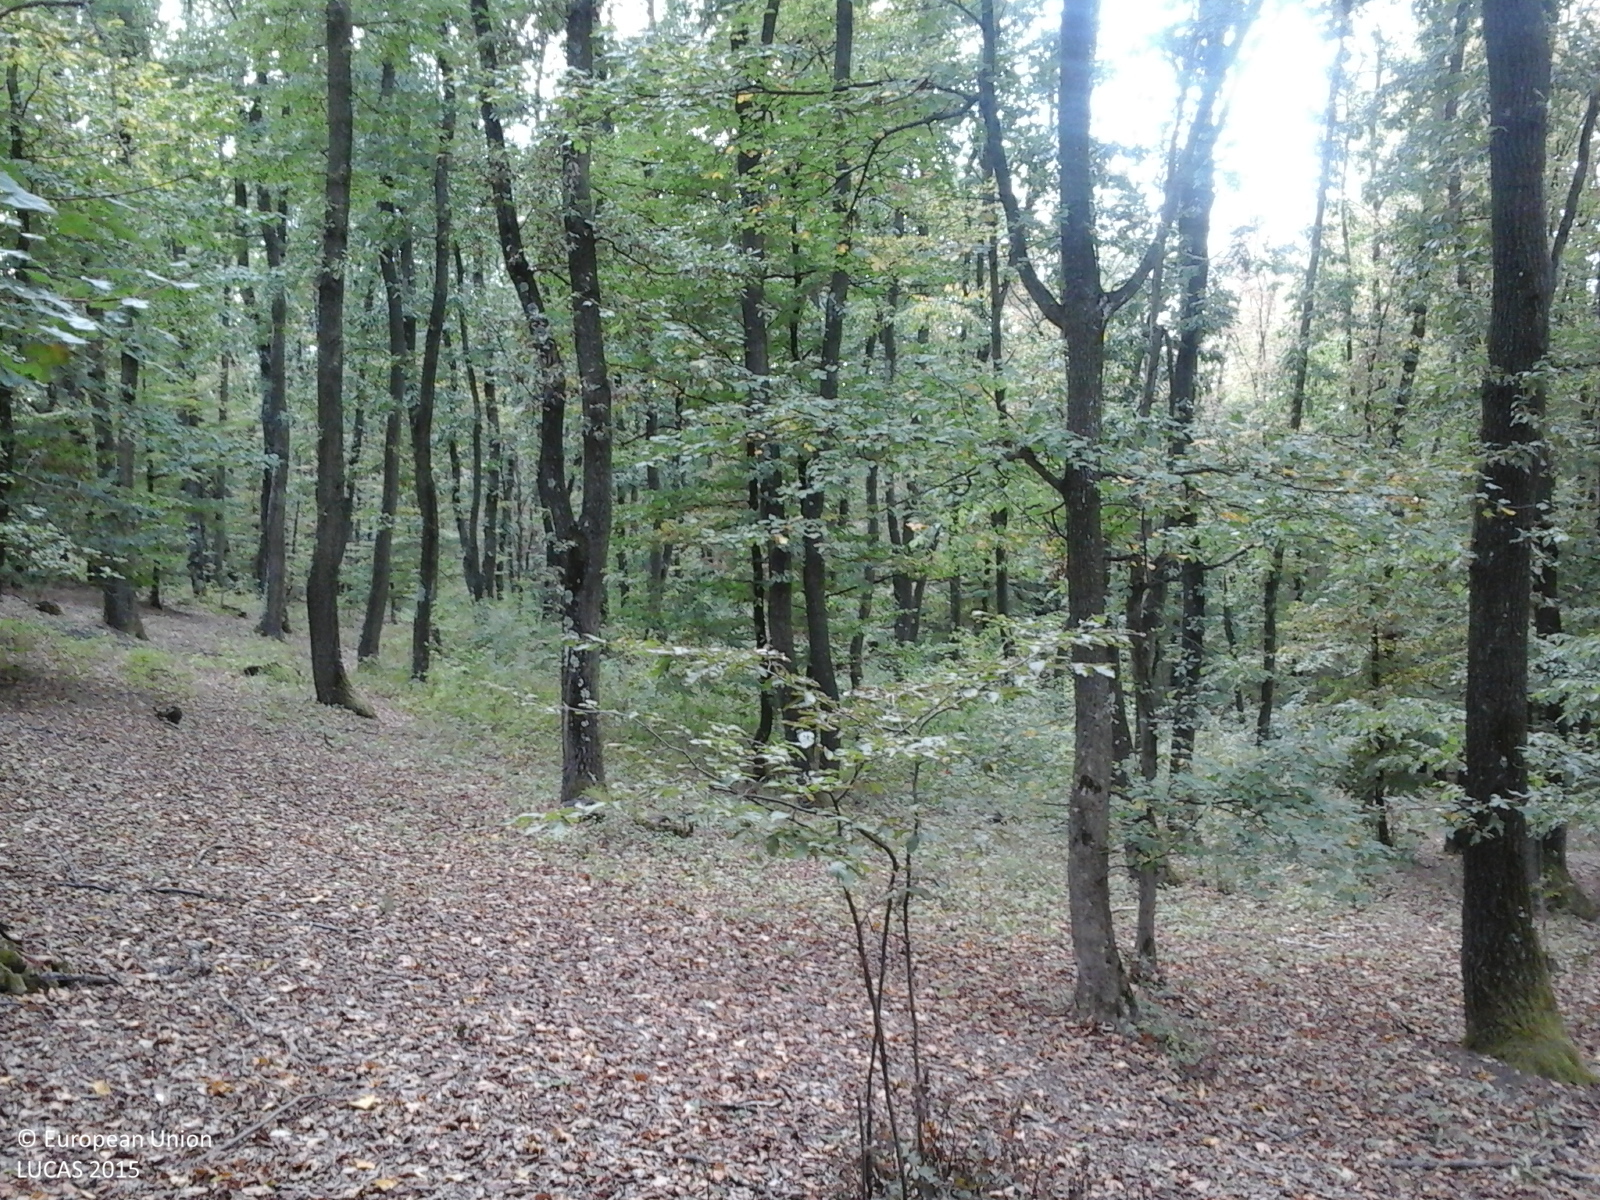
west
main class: Woodland
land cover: Broadleaved woodland
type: mesophytic deciduous forest
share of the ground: > 75 %
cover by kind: broadleaved forest trees 100 %
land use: Forestry
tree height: > 5 m
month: September
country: RO
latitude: 47.3044
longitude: 23.1472
